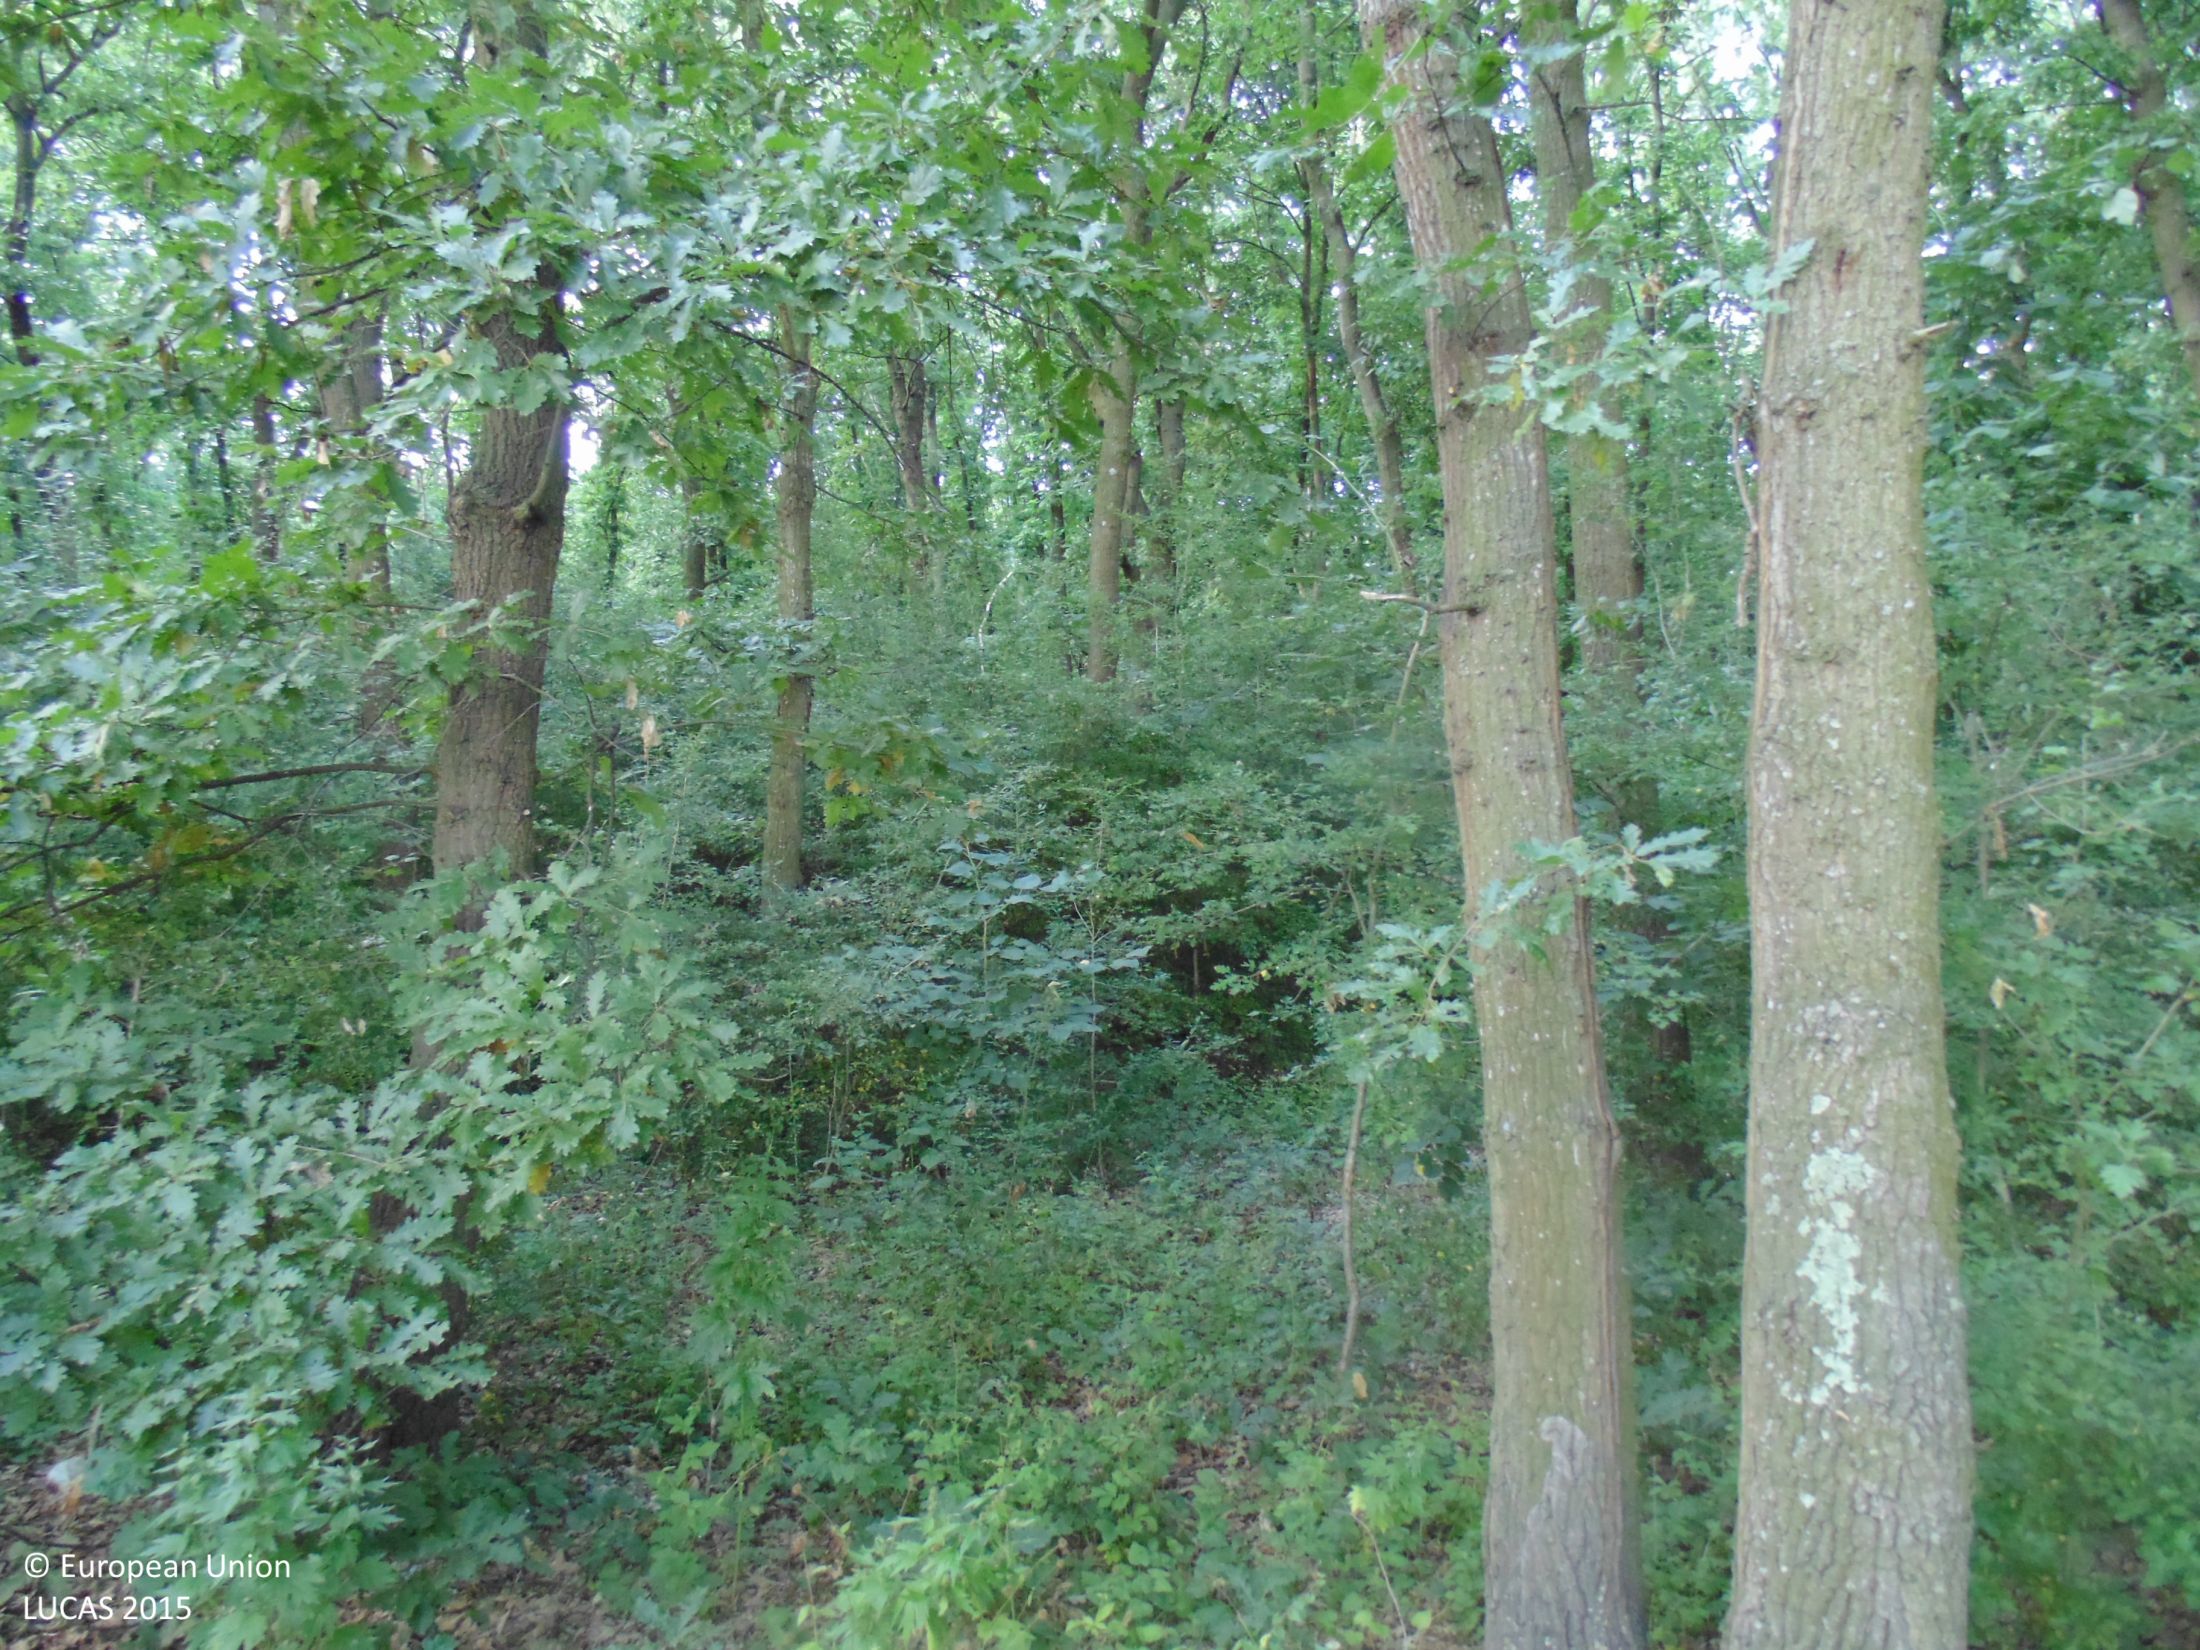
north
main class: Woodland
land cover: Broadleaved woodland
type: mesophytic deciduous forest
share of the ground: > 75 %
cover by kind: broadleaved forest trees 90 %, shrubs 5 %, herbaceous plants 5 %
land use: Forestry
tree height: > 5 m
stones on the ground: < 10 %
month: July
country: BG
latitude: 43.5203
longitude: 27.6666
